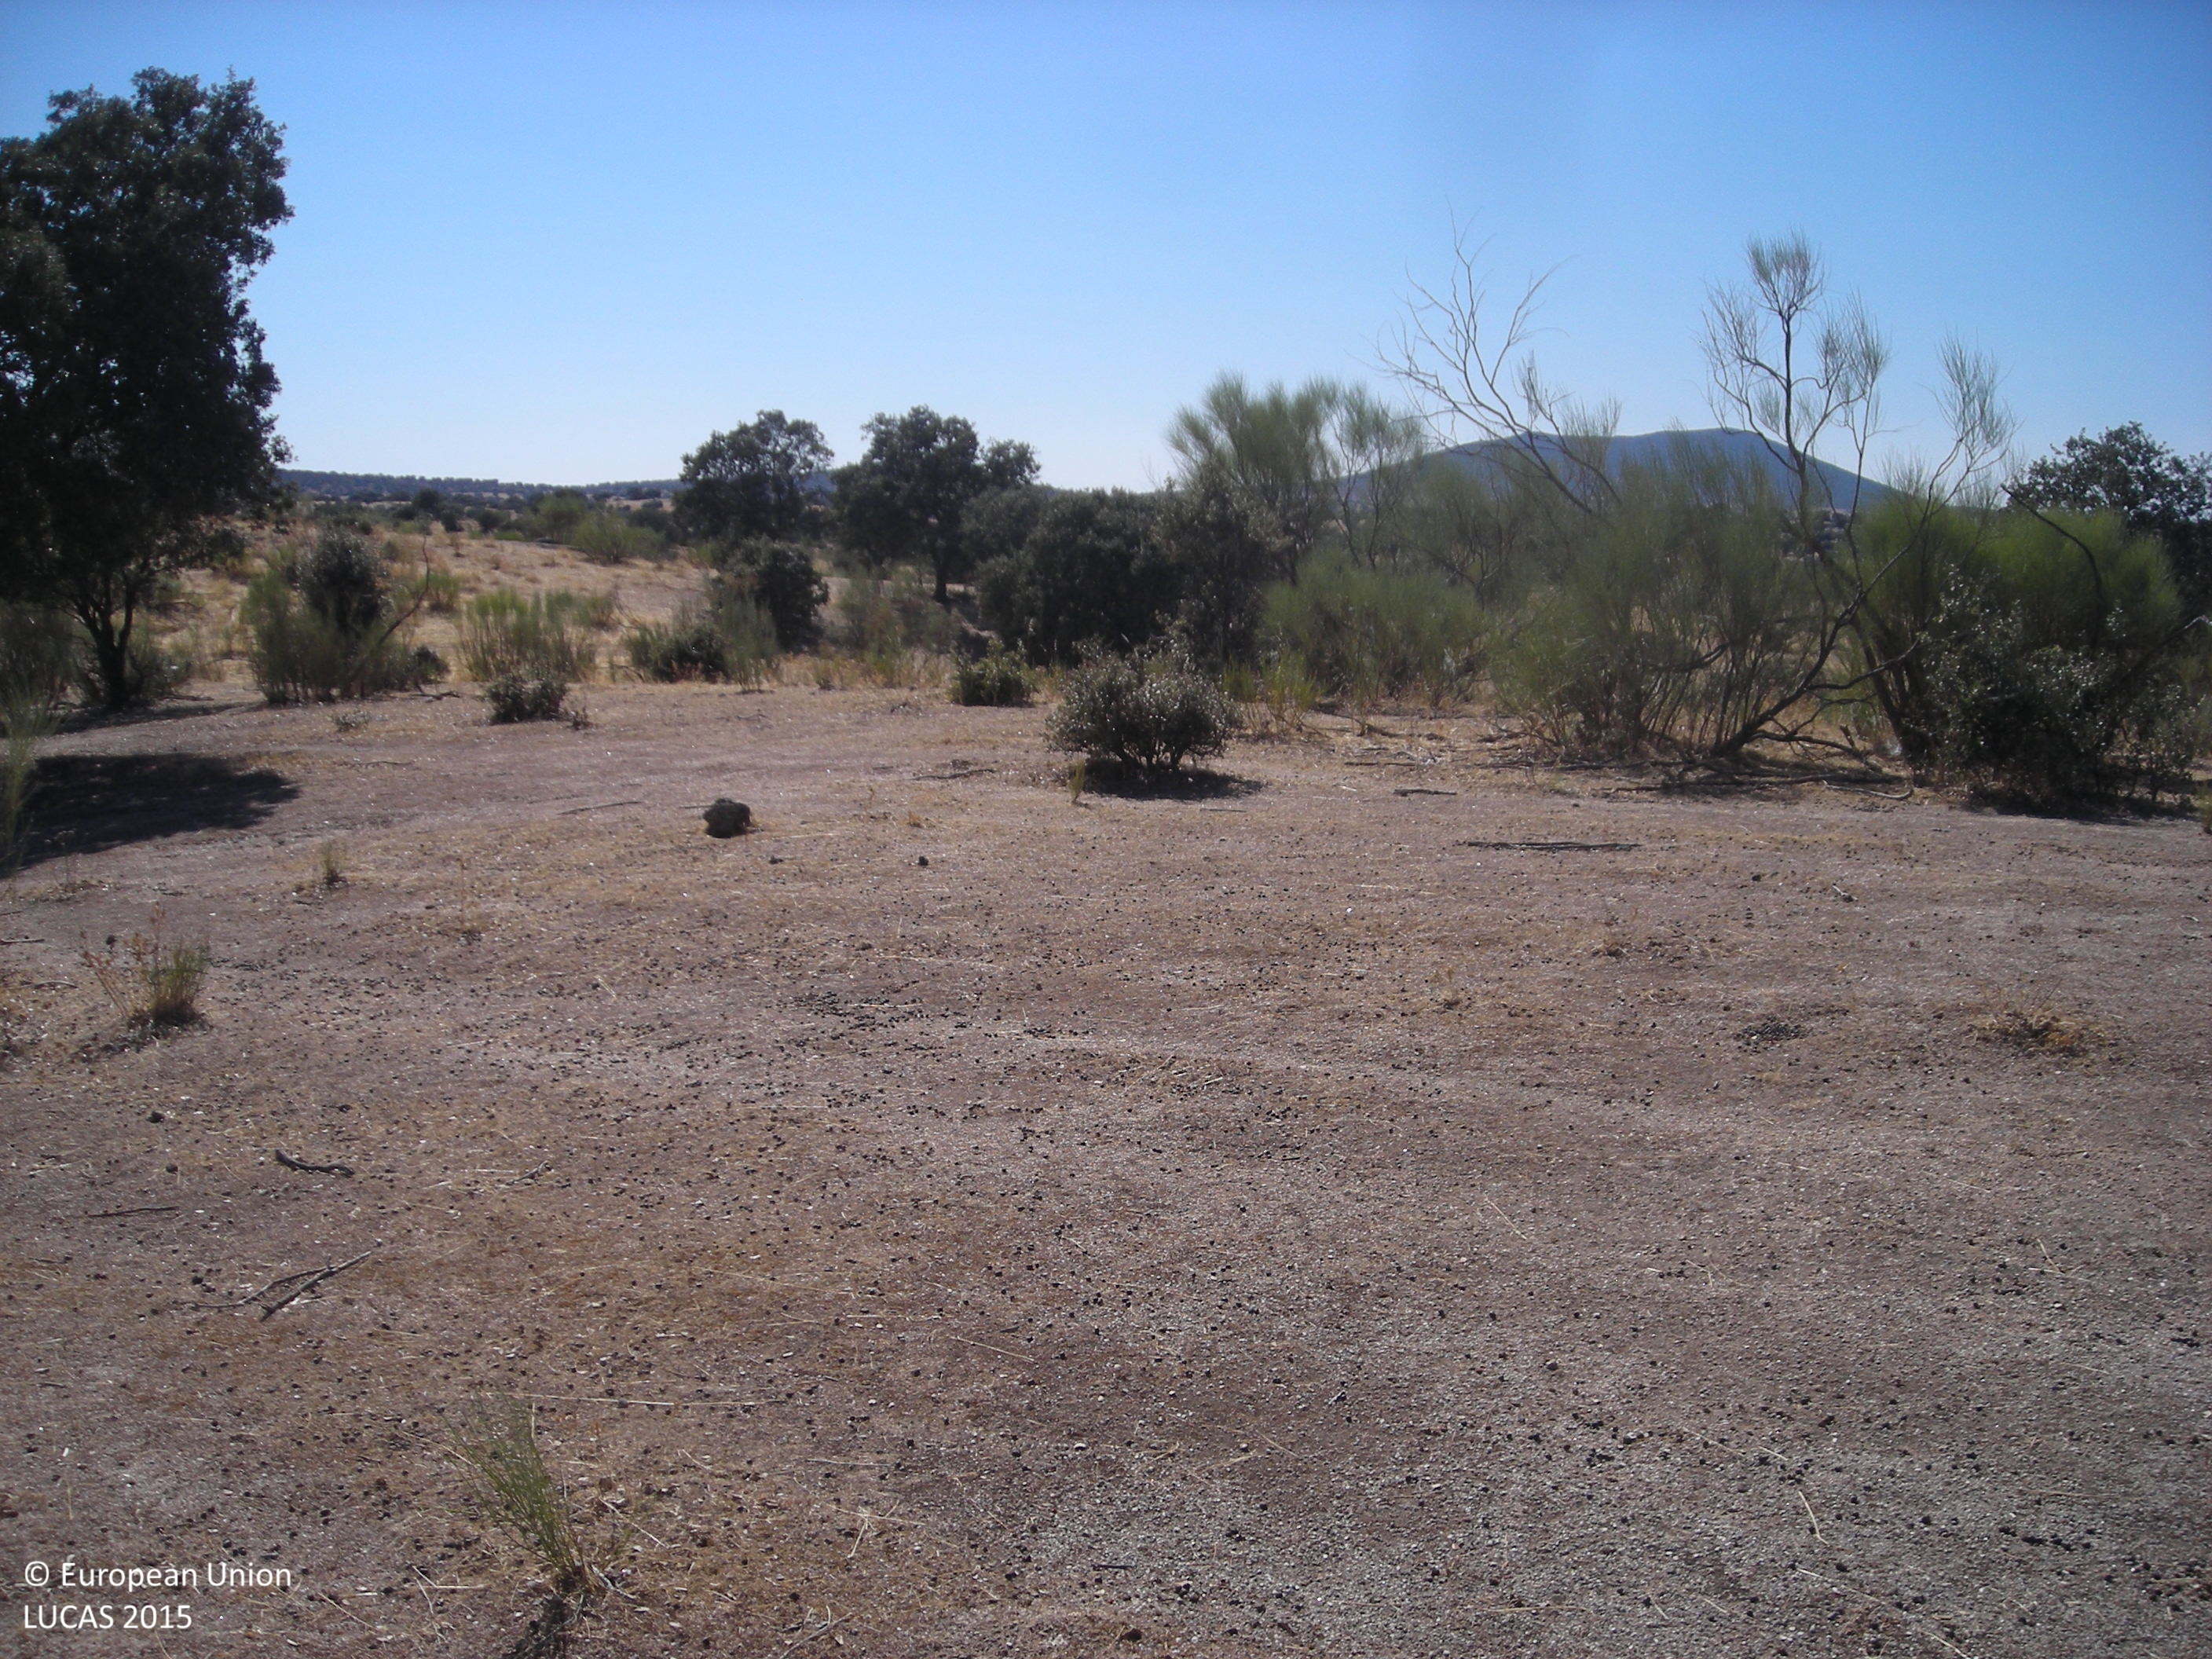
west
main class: Shrubland
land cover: Shrubland with sparse tree cover
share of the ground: > 75 %
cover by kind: shrubs 95 %, broadleaved forest trees 5 %
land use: Agriculture (excluding fallow land and kitchen gardens)
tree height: > 5 m
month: July
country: ES
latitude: 38.8496
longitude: -5.7974
